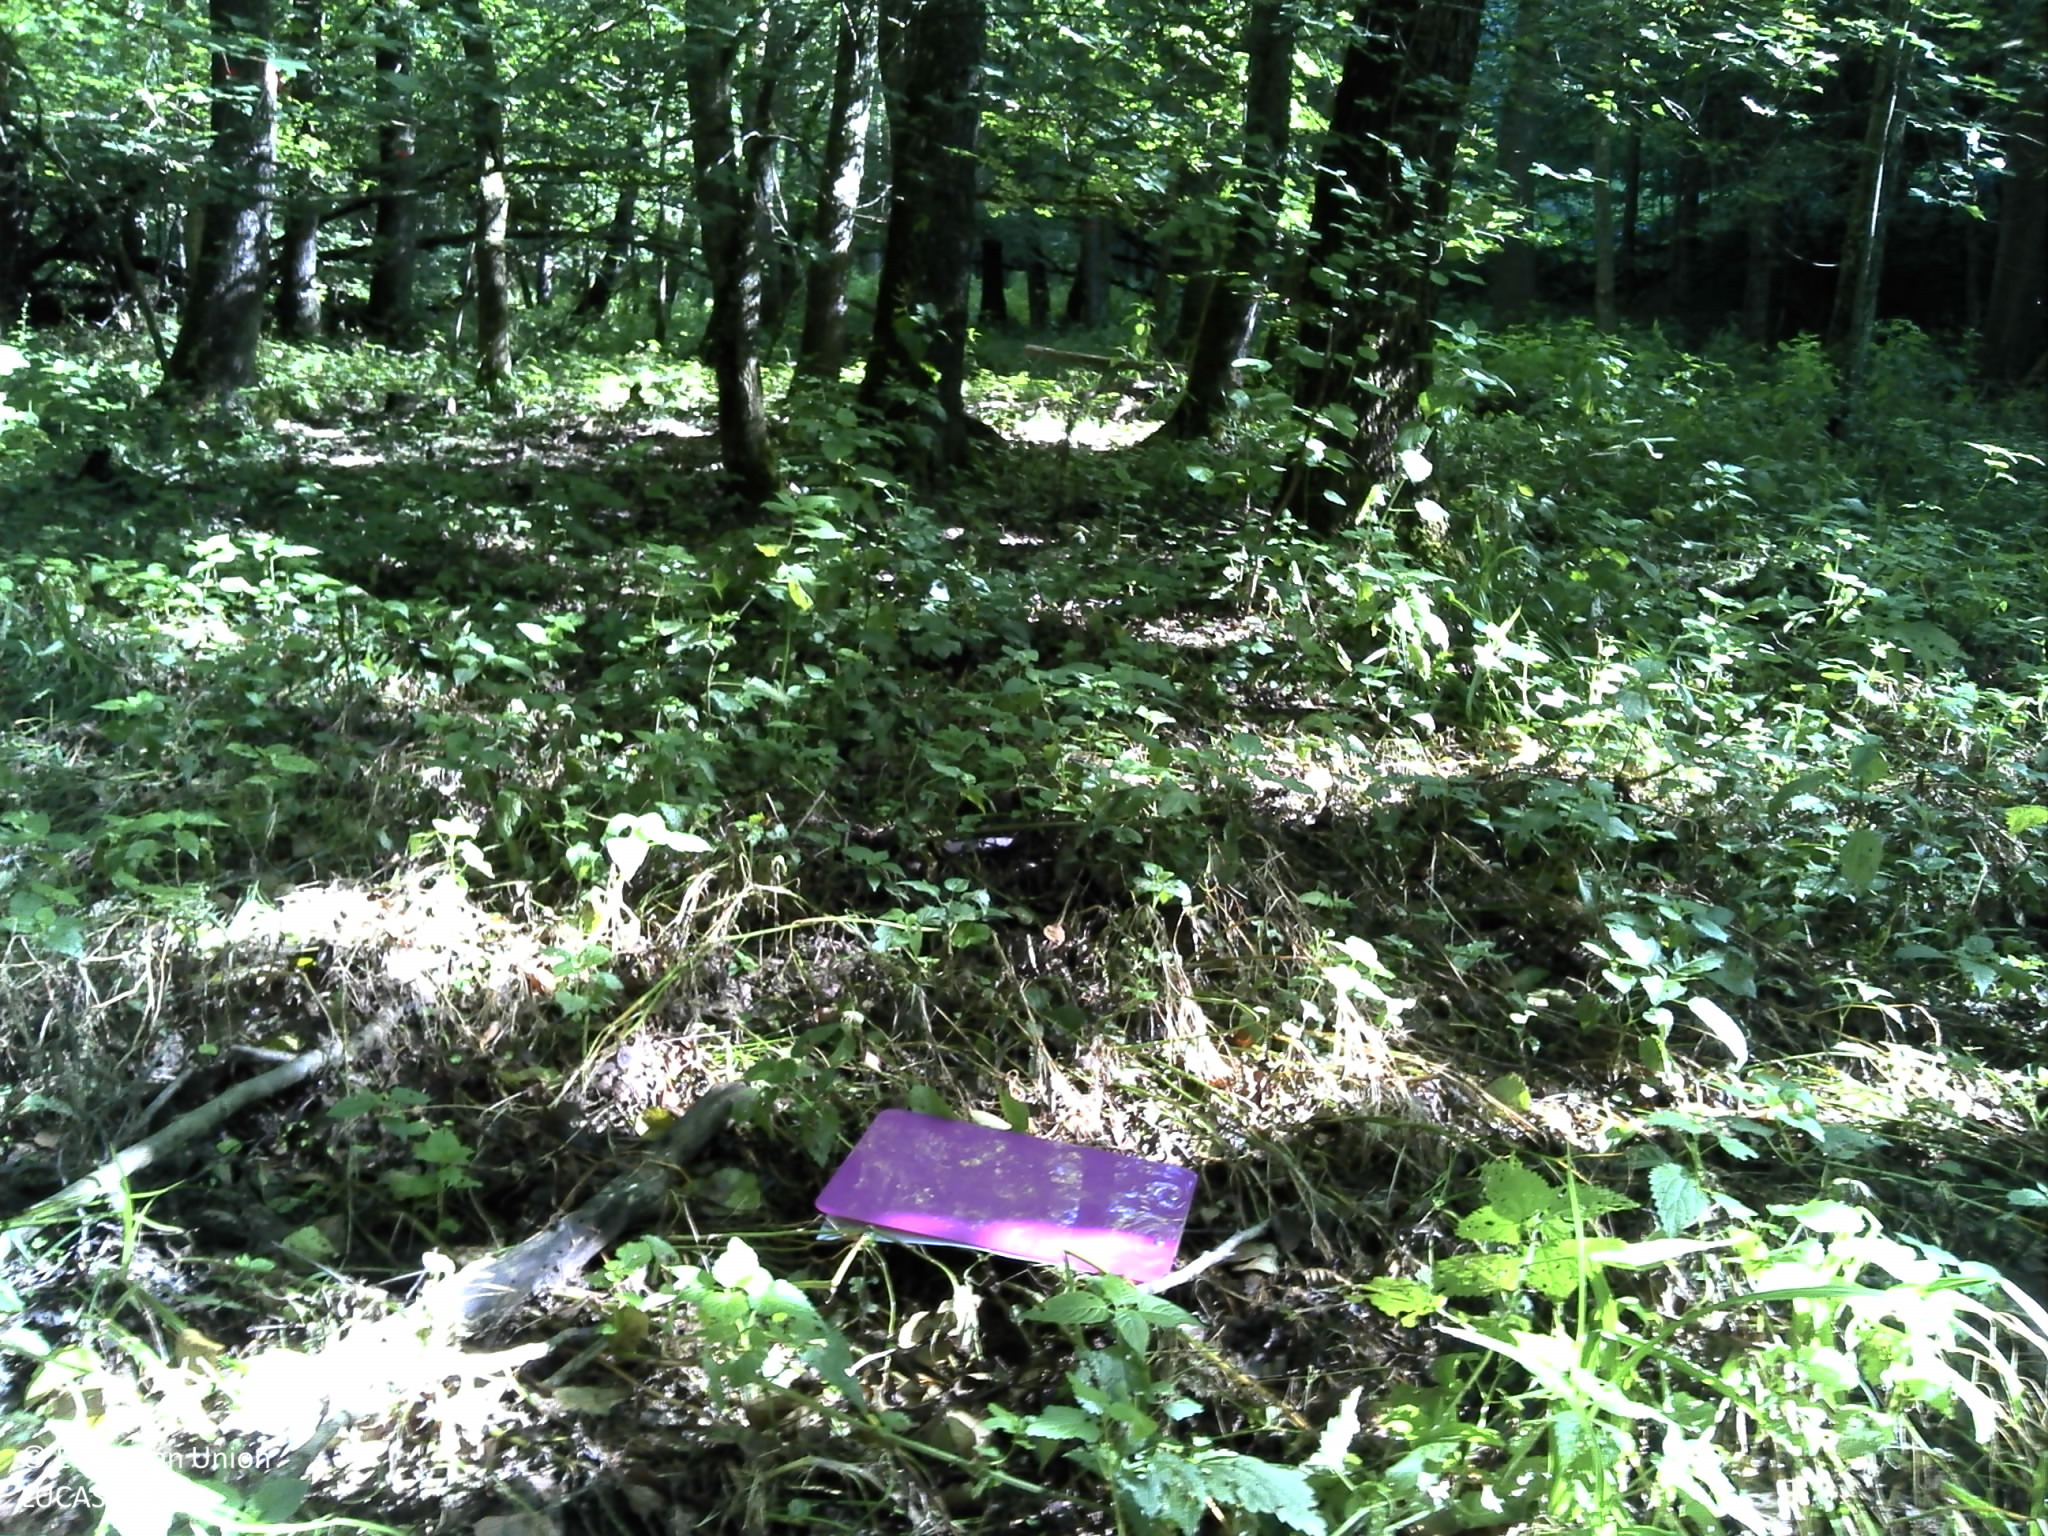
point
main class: Woodland
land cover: Broadleaved woodland
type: acidophilous oak and oak-birch forest
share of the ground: > 75 %
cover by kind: broadleaved forest trees 90 %, shrubs 5 %, herbaceous plants 5 %
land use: Forestry
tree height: > 5 m
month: June
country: HR
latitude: 45.6580
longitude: 17.6902
